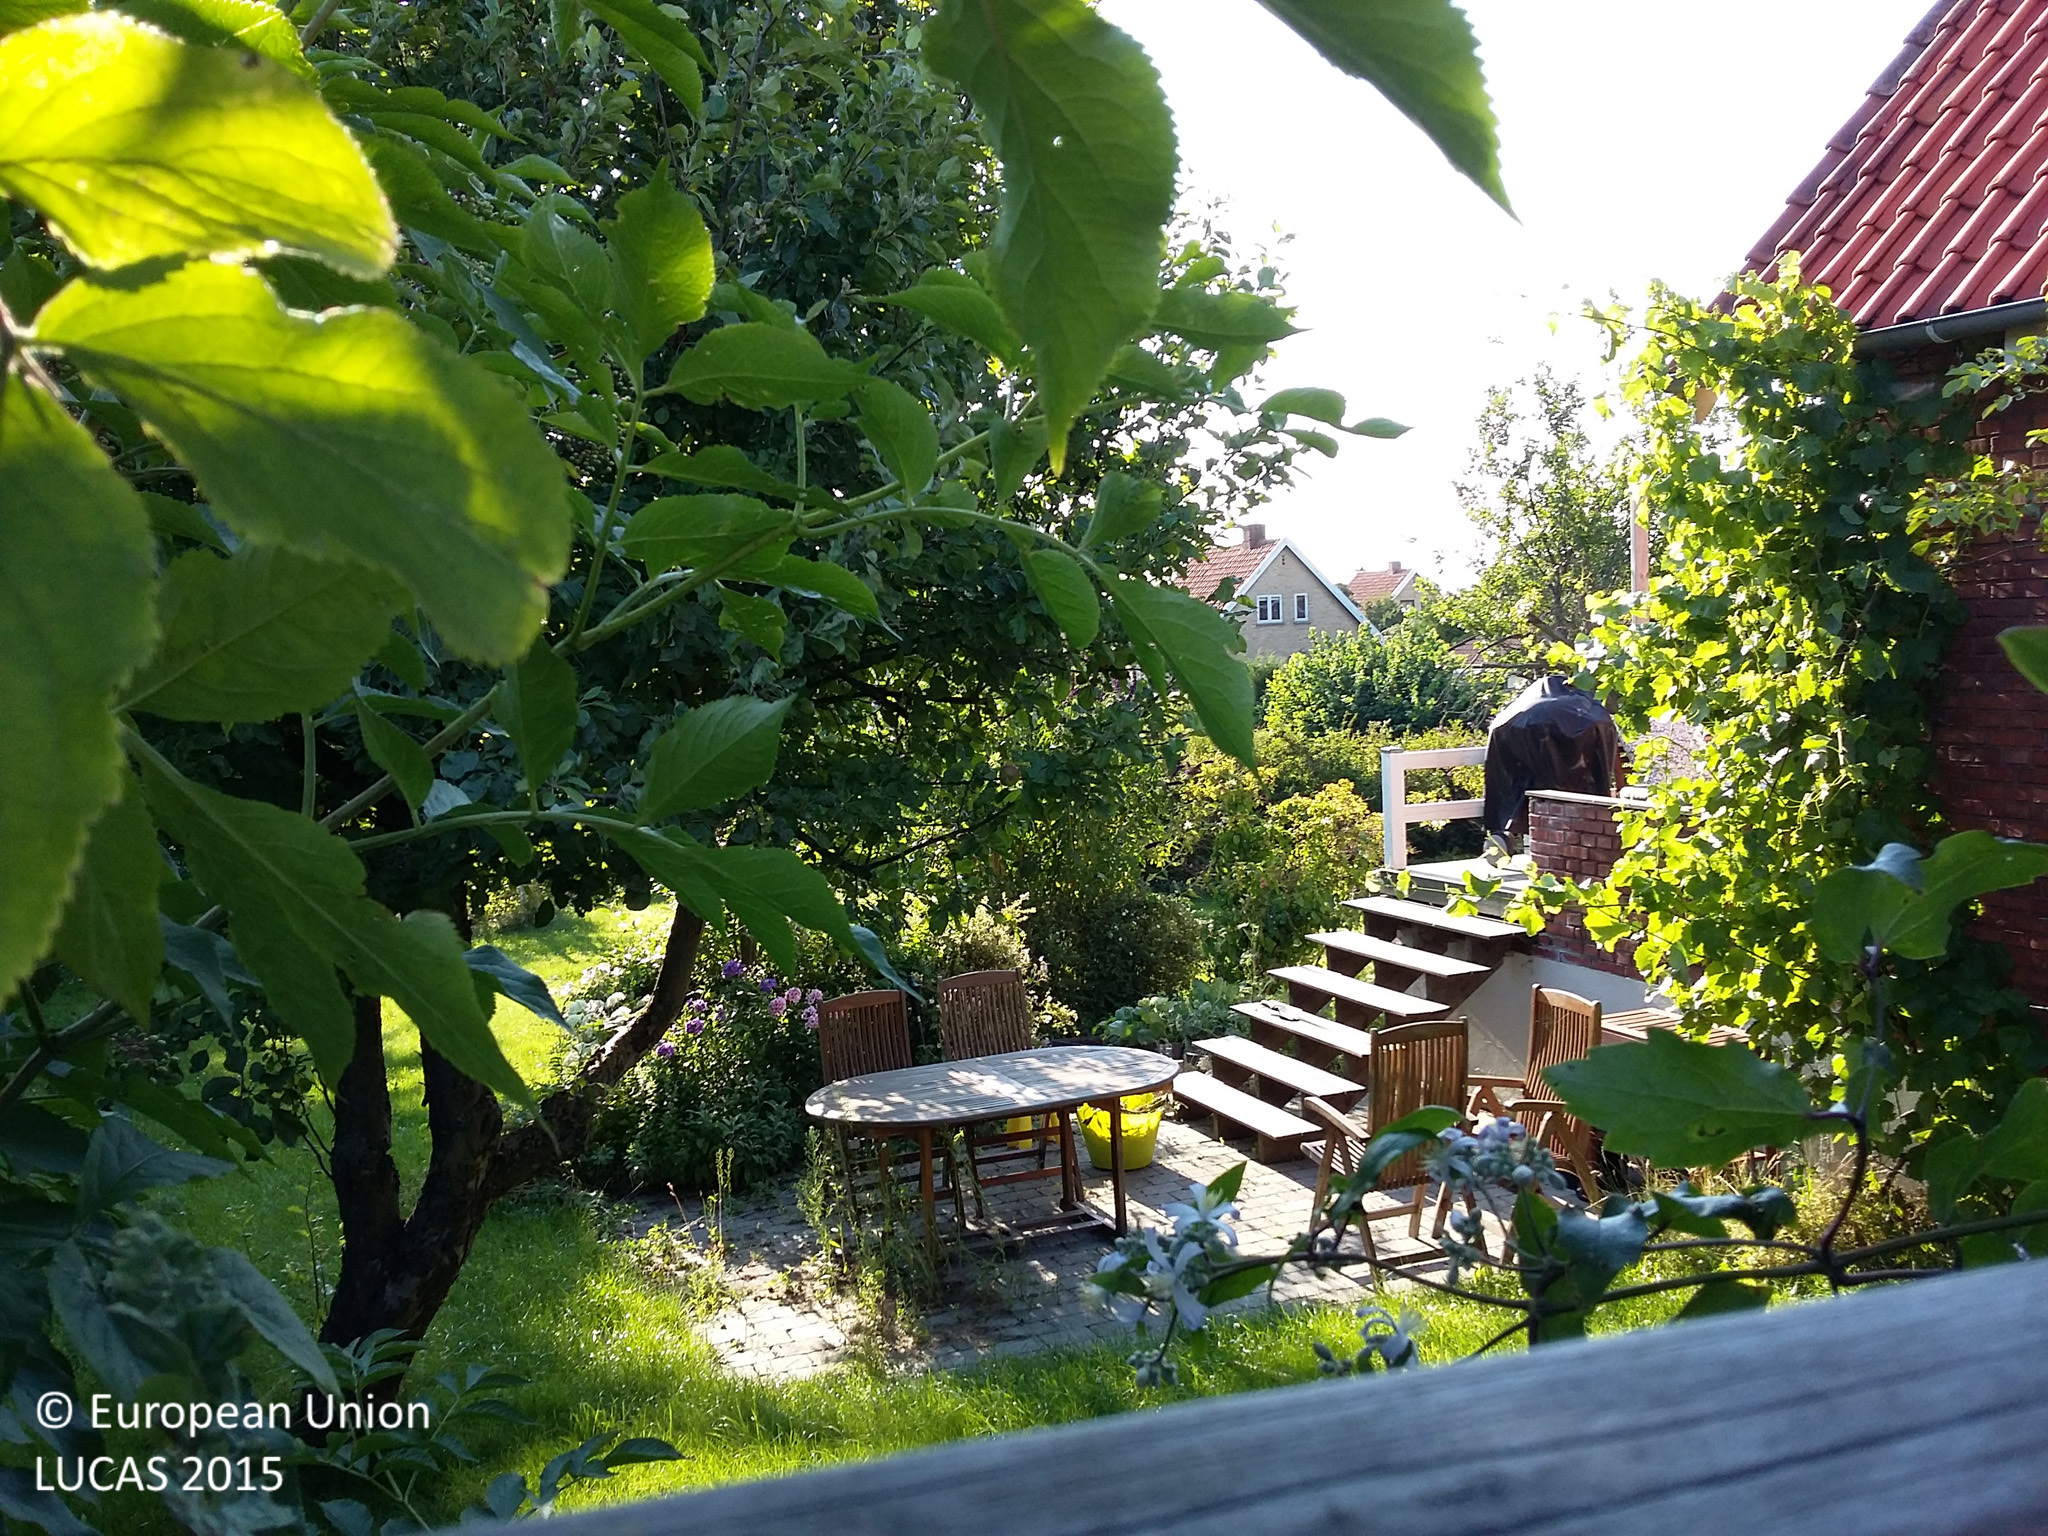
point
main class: Grassland
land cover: Grassland with sparse tree/shrub cover
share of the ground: > 75 %
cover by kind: herbaceous plants 85 %, shrubs 10 %, broadleaved forest trees 5 %
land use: Residential
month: August
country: DK
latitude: 55.6489
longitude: 12.1117
